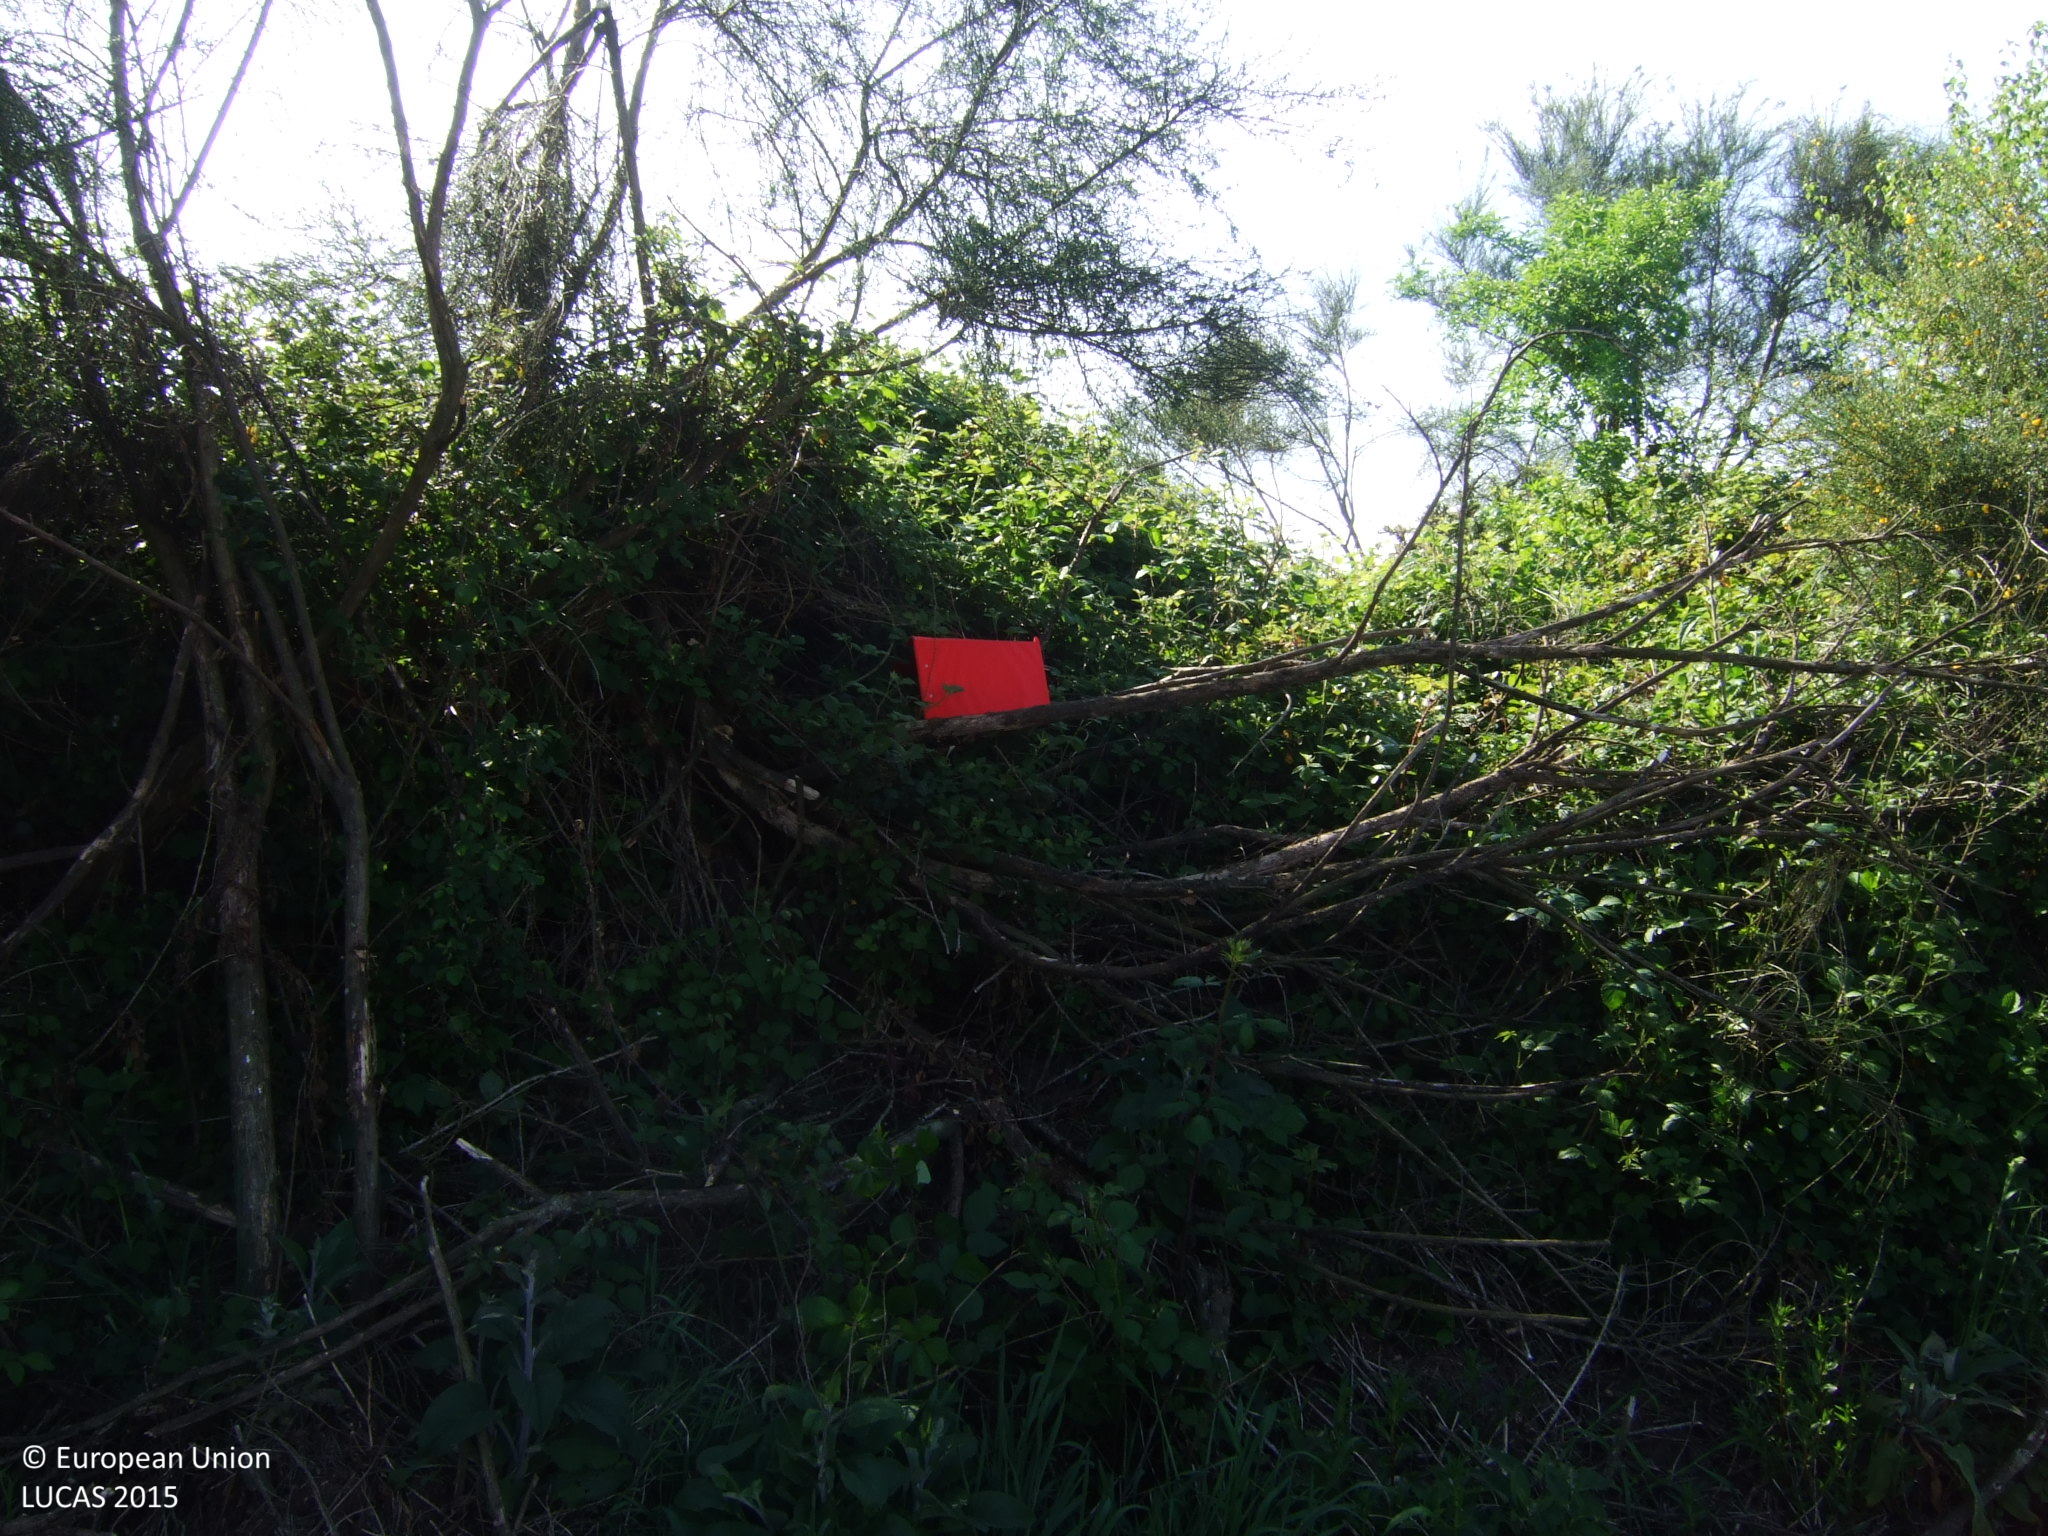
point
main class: Shrubland
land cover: Shrubland with sparse tree cover
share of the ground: > 75 %
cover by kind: shrubs 95 %, broadleaved forest trees 5 %
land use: Abandoned areas
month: May
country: ES
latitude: 43.0865
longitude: -7.4067
